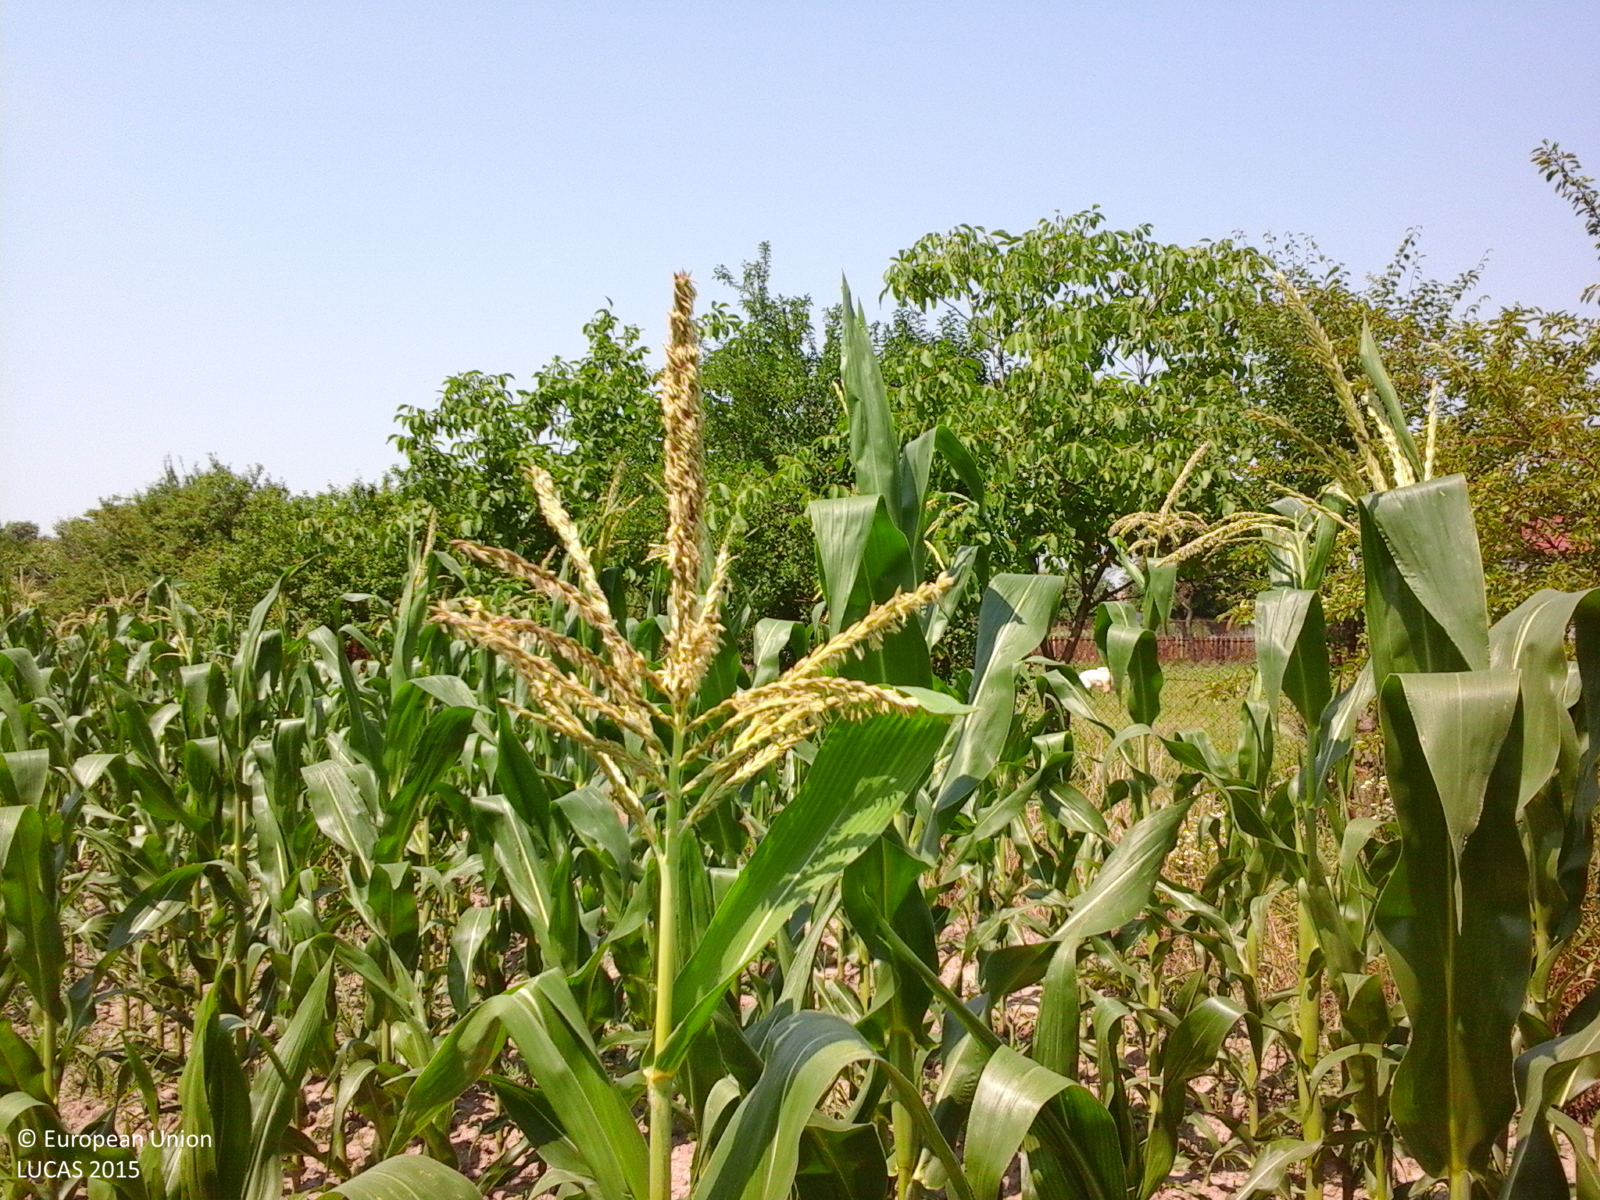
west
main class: Cropland
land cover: Maize
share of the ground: > 75 %
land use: Agriculture (excluding fallow land and kitchen gardens)
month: July
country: RO
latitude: 44.7469
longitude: 25.6713
